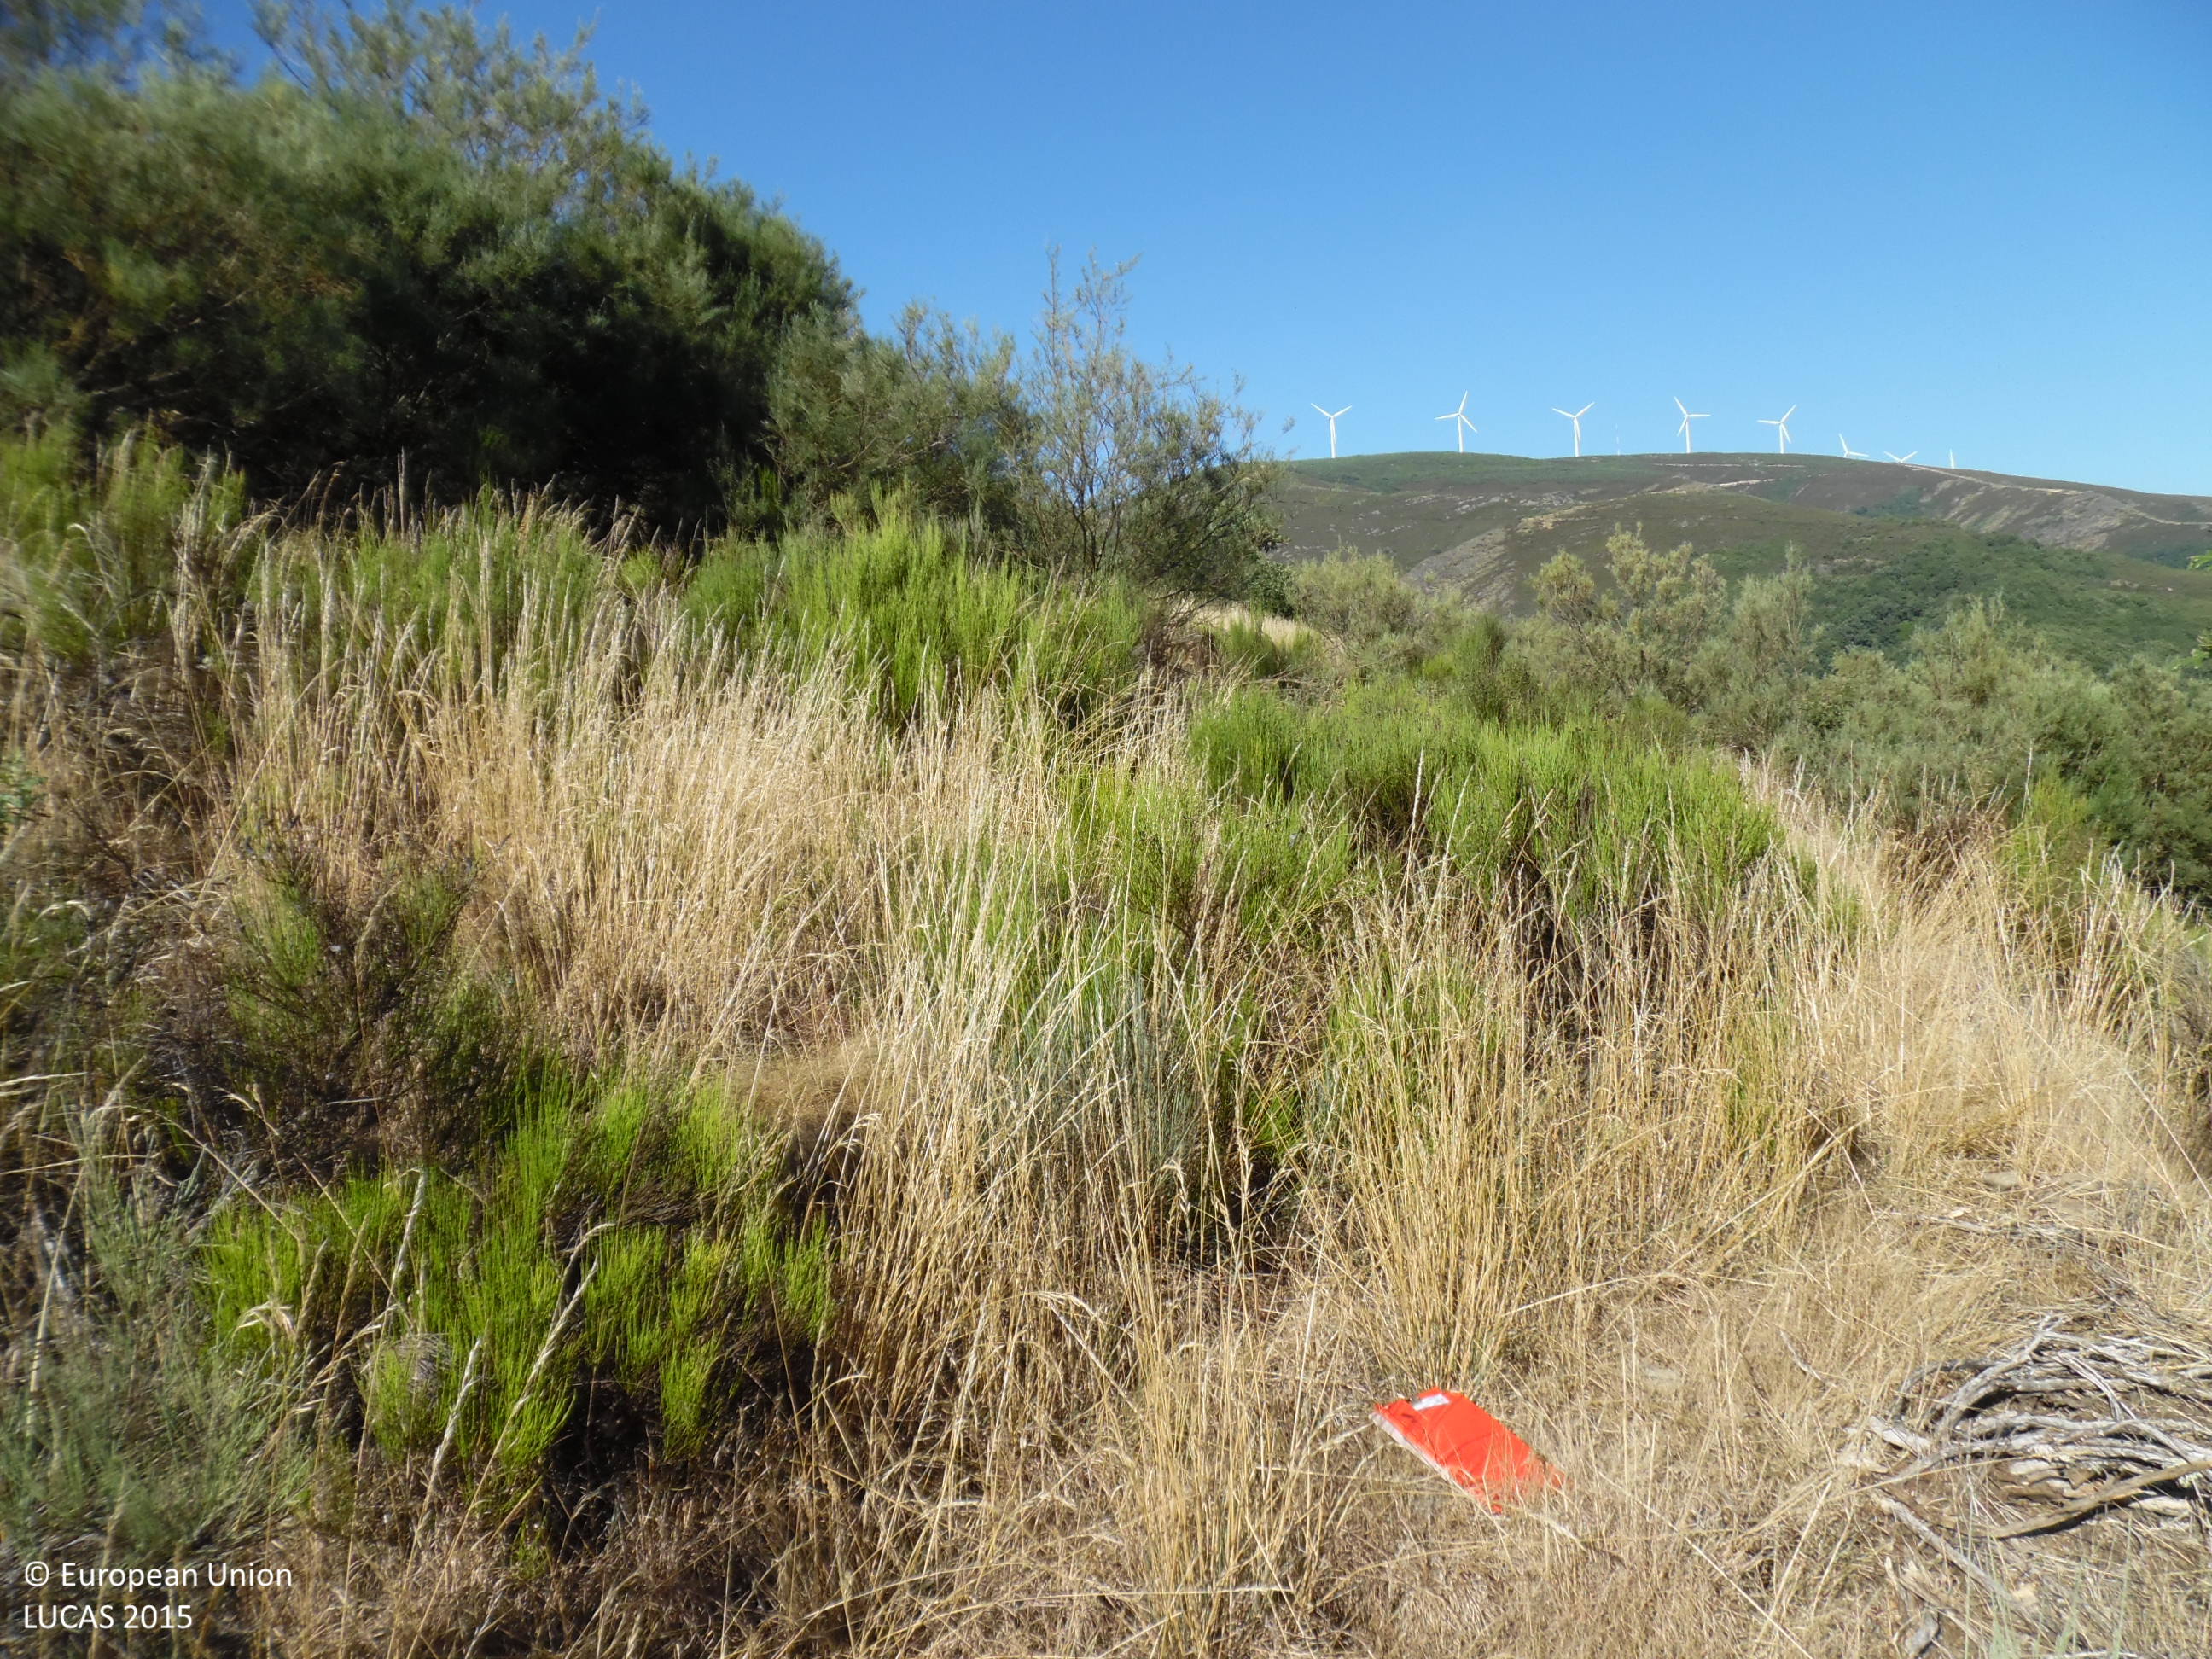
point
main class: Shrubland
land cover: Shrubland with sparse tree cover
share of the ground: > 75 %
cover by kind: shrubs 95 %, broadleaved forest trees 5 %
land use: Abandoned areas
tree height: > 5 m
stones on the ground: 10 - 25 %
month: August
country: ES
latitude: 42.7367
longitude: -6.1995
